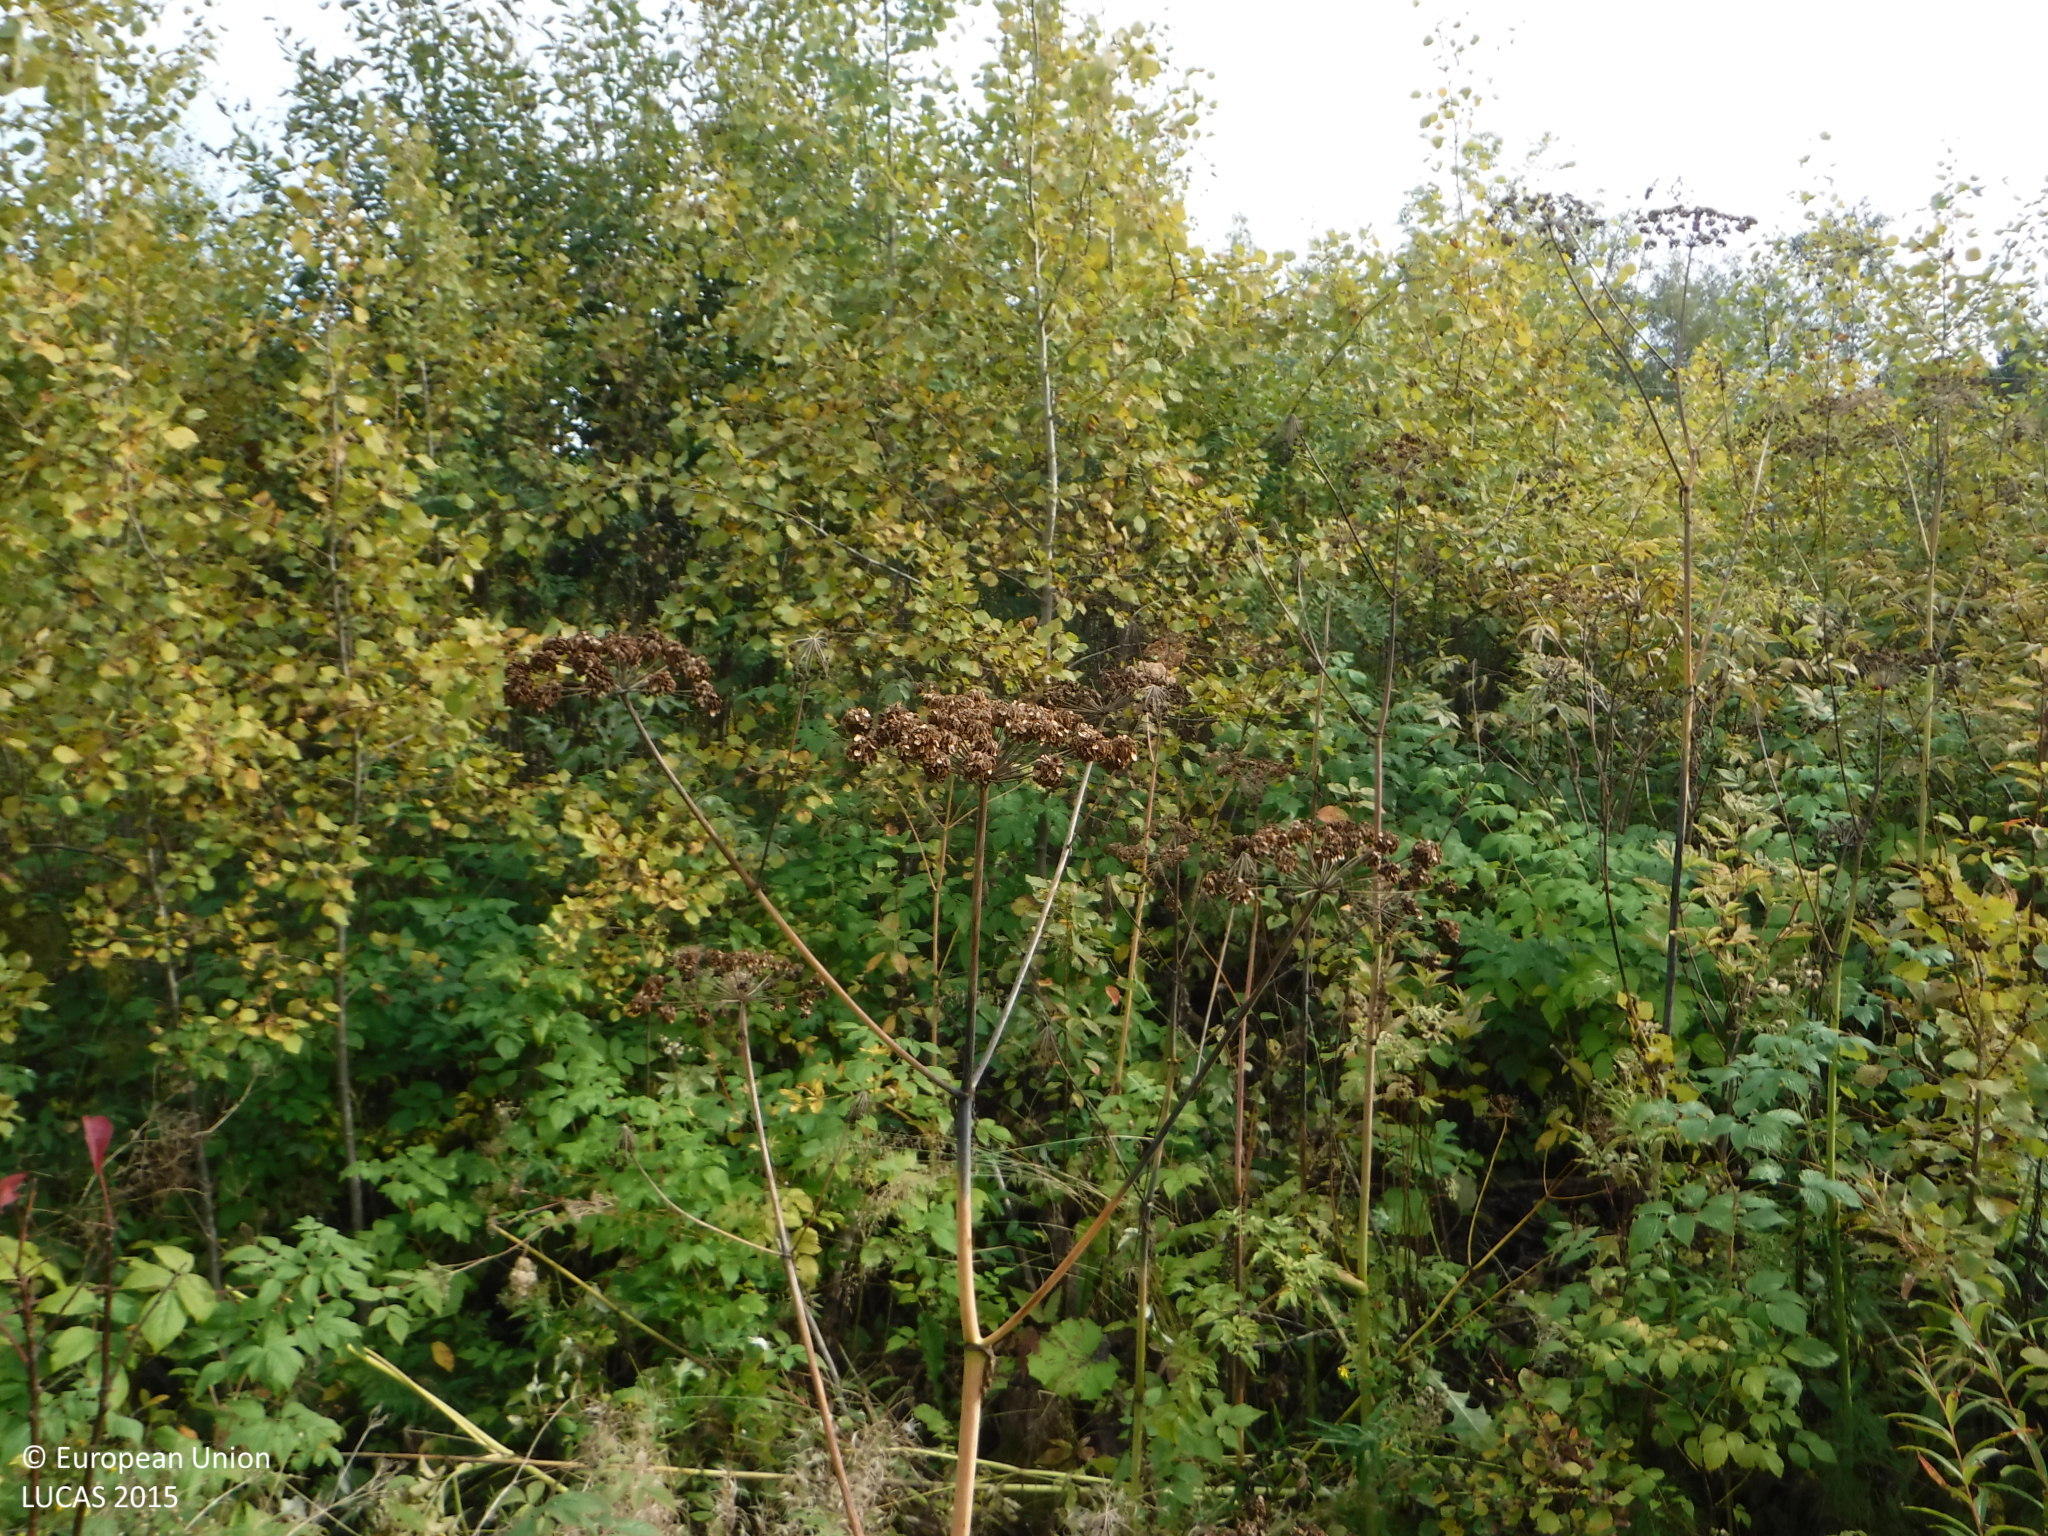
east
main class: Woodland
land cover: Broadleaved woodland
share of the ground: > 75 %
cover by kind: broadleaved forest trees 75 %, shrubs 20 %, herbaceous plants 5 %
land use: Semi-natural and natural areas not in use
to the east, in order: Broadleaved woodland; Rivers and streams; Broadleaved woodland; Ditches and canals; Electric lines; Grassland without tree/shrub cover; Ditches and canals; Grassland without tree/shrub cover; Abandoned hedges; Artificial constructions in urban areas; Broadleaved woodland; Tracks; Broadleaved woodland
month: September
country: FI
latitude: 61.4213
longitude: 23.0209
